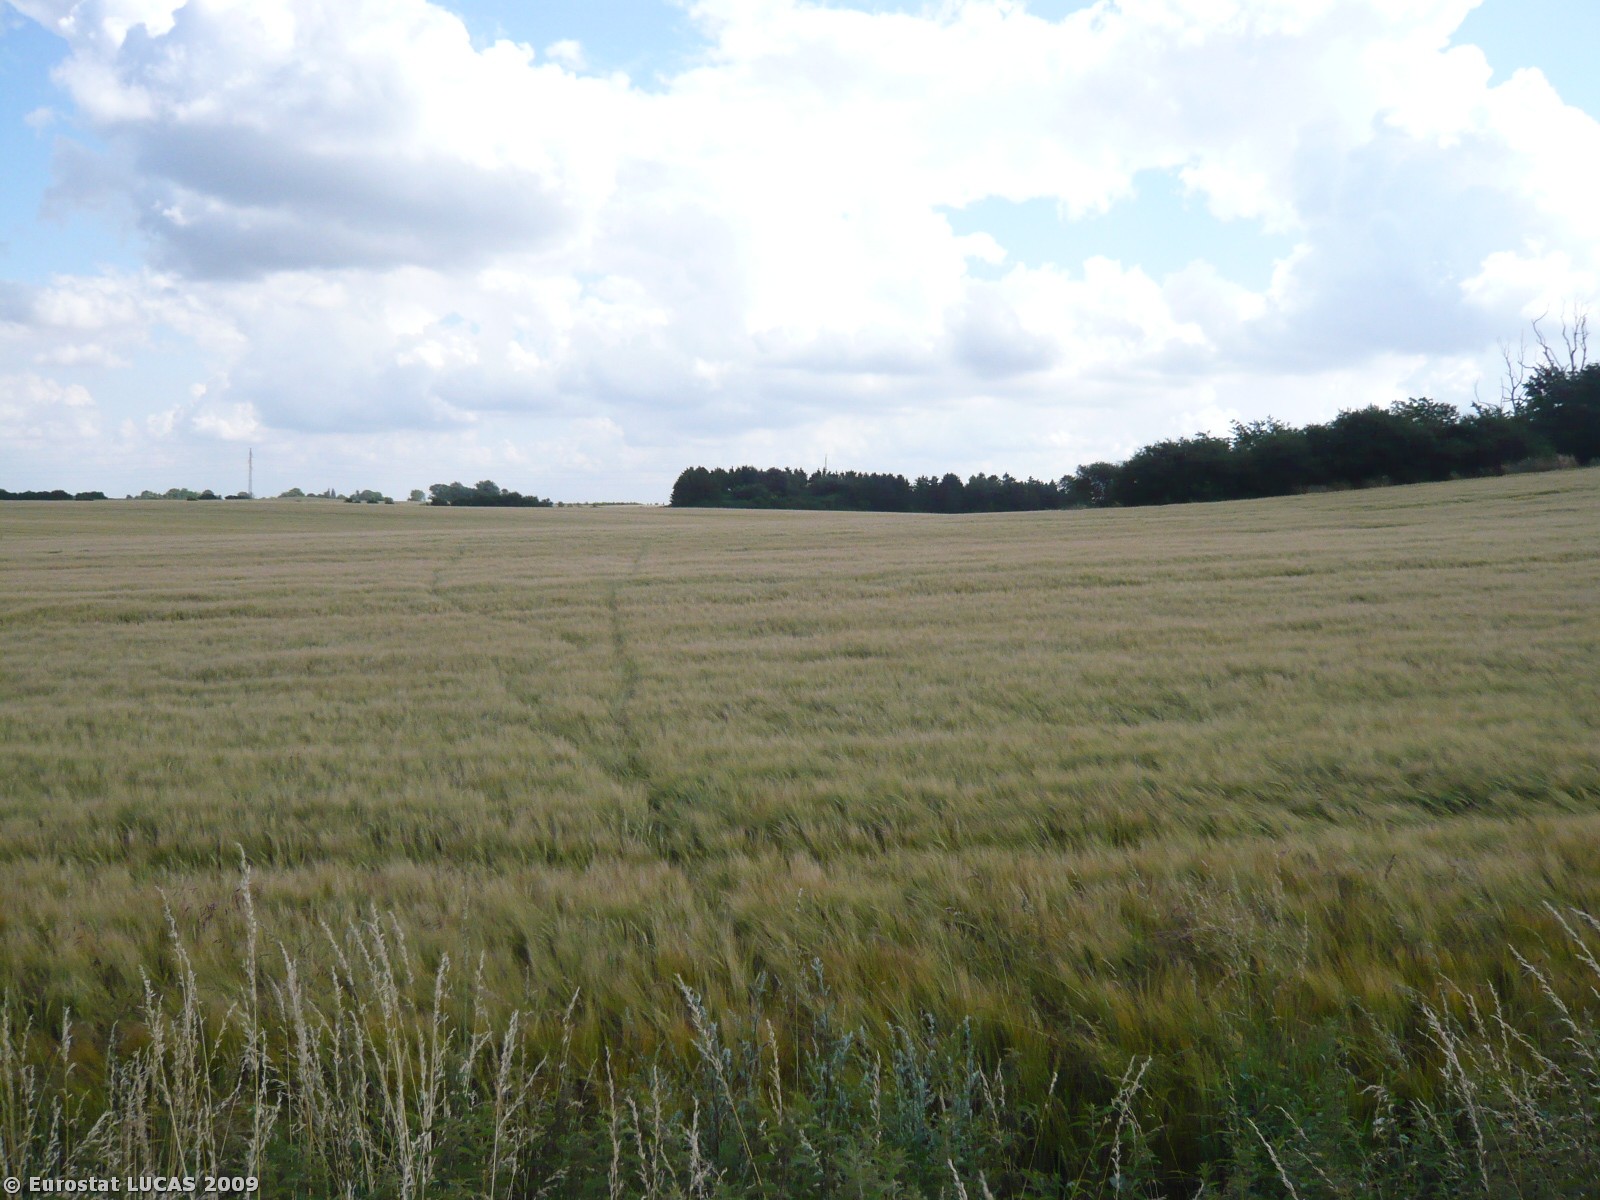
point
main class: Cropland
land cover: Barley
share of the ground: > 75 %
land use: Agriculture (excluding fallow land and kitchen gardens)
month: July
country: DK
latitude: 55.6902
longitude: 11.7641
